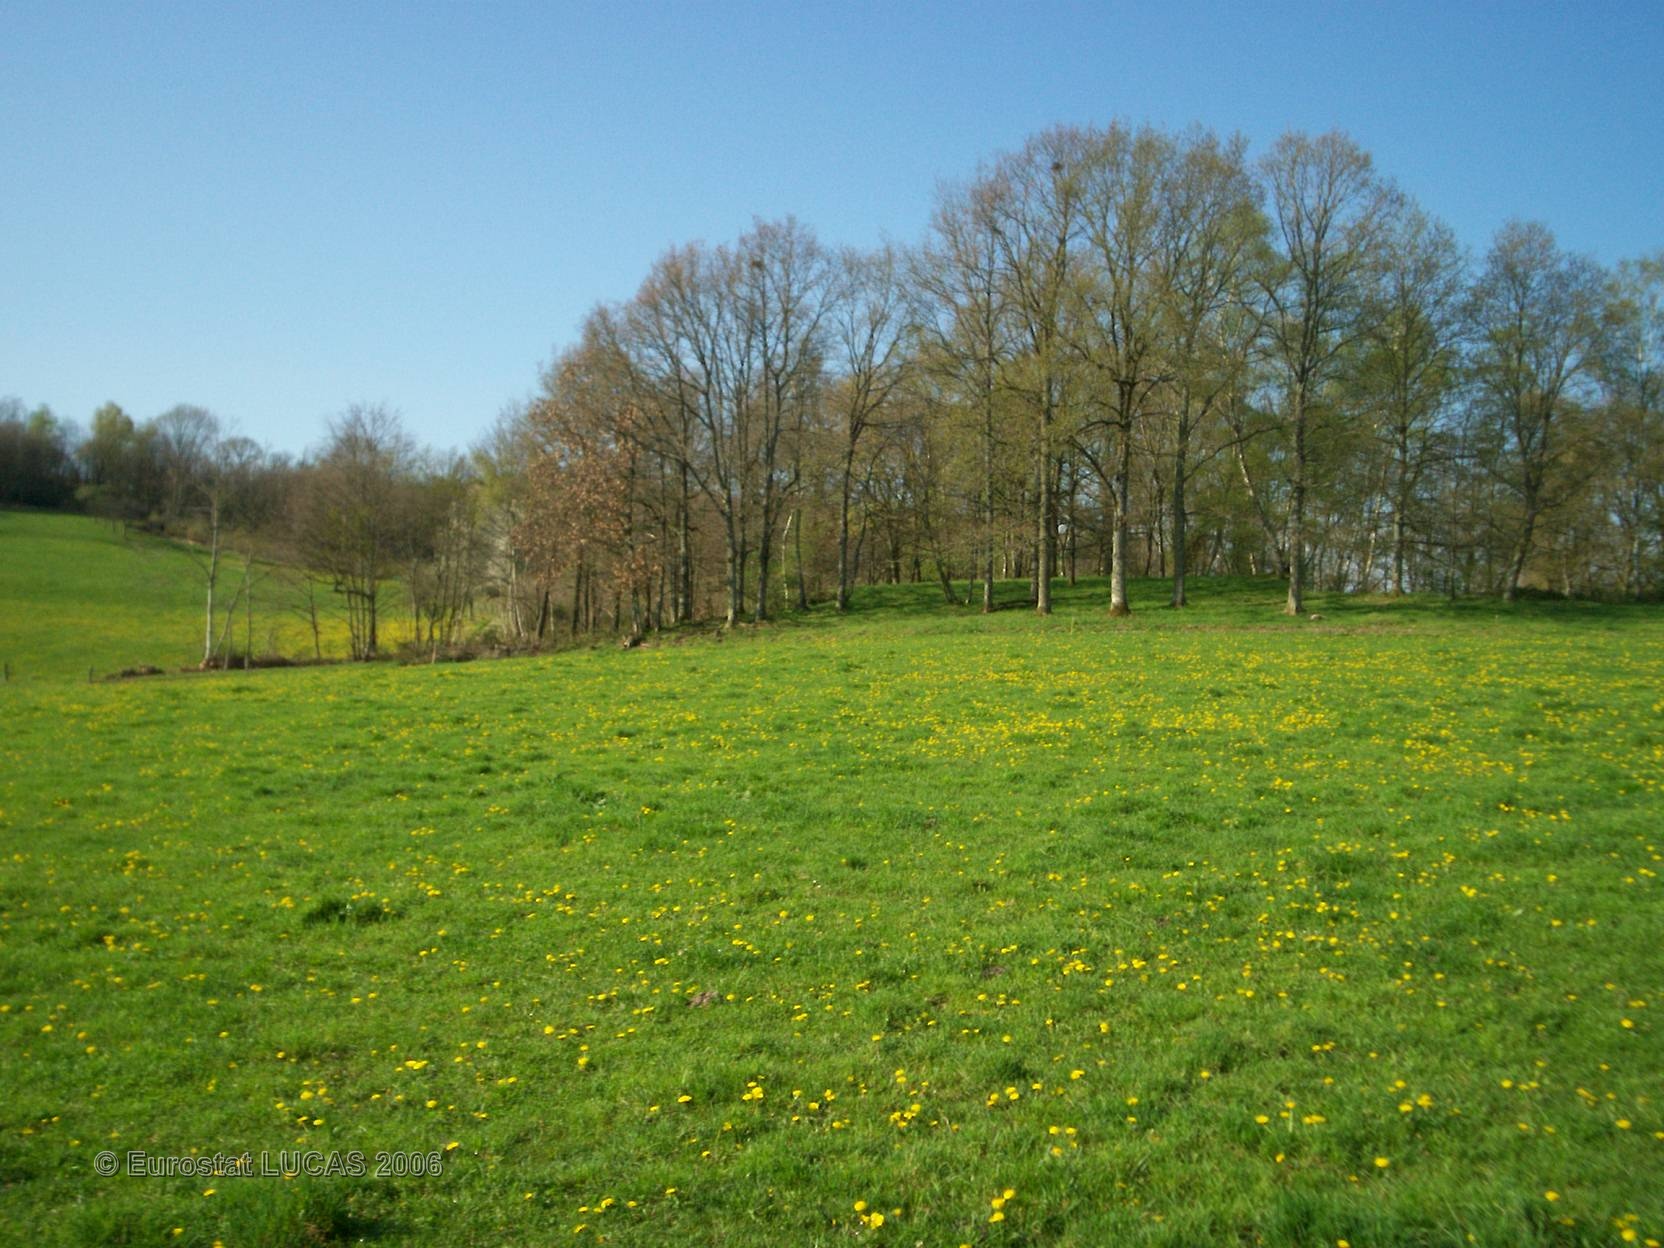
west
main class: Grassland
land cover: Grassland without tree/shrub cover
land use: Agriculture (excluding fallow land and kitchen gardens)
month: April
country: FR
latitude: 46.1401
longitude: 1.5121
